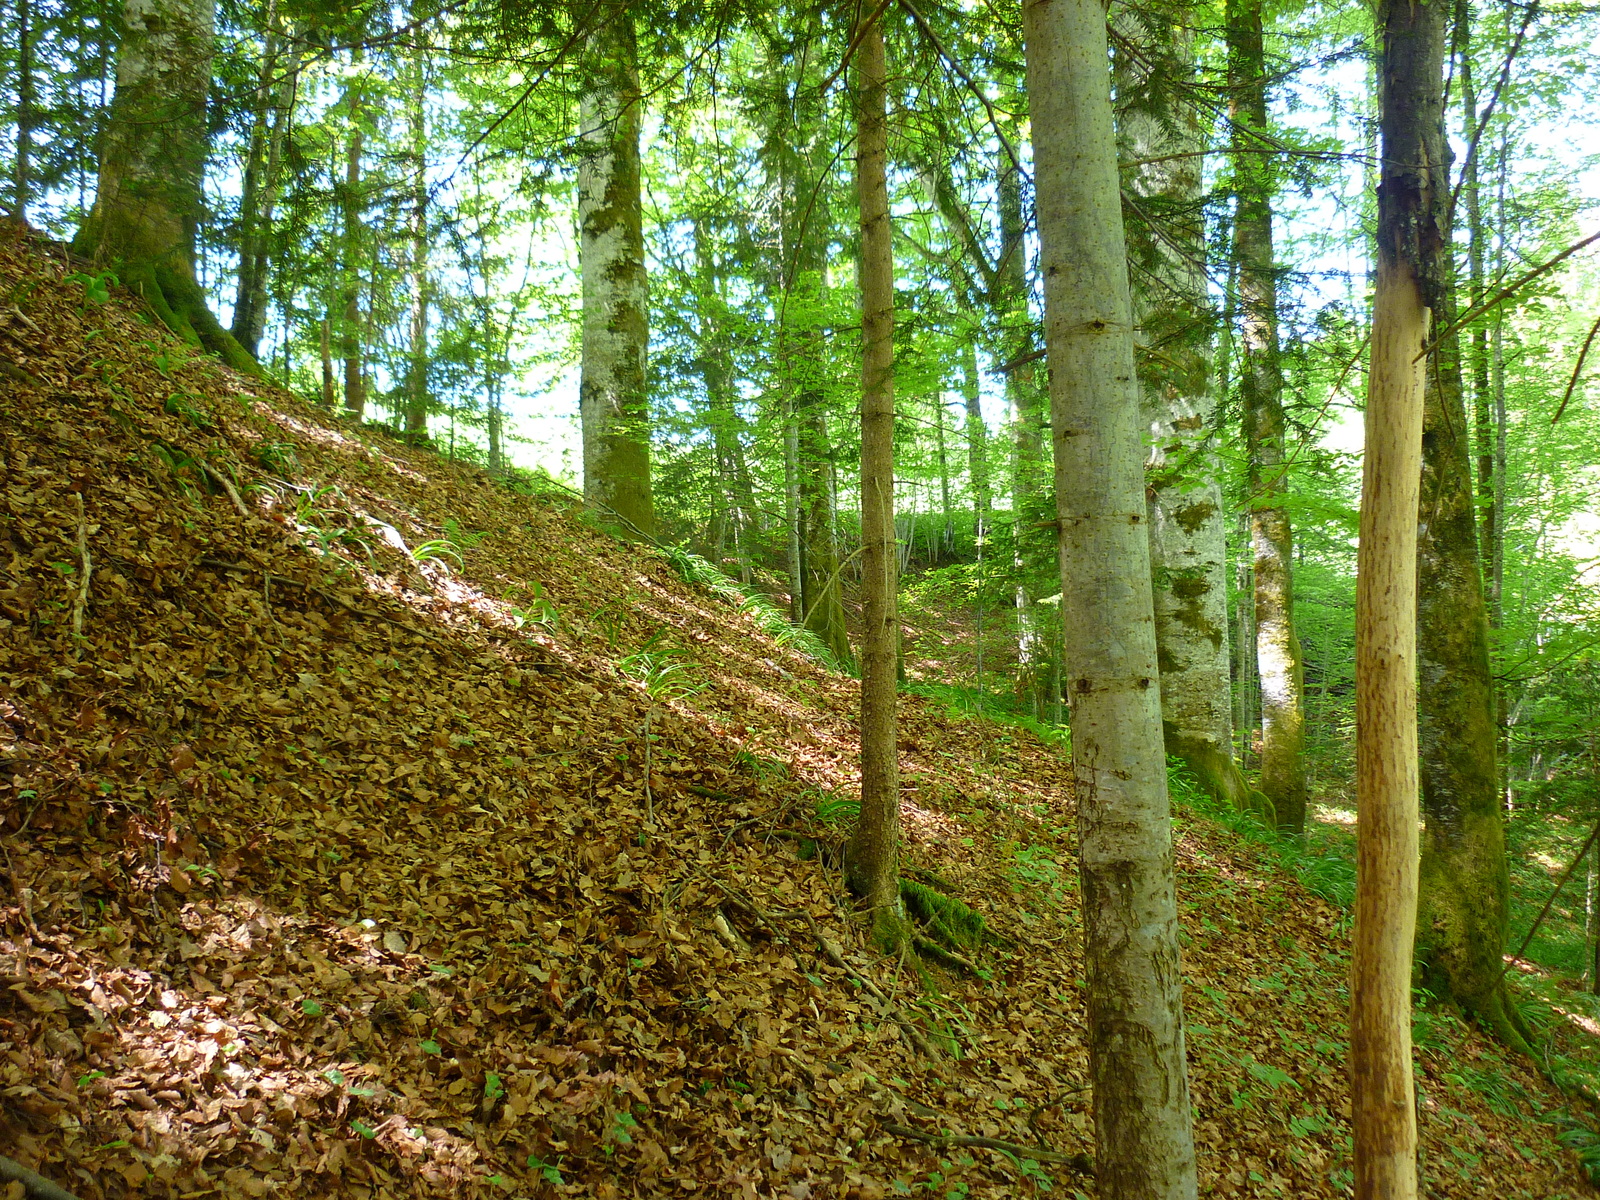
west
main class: Woodland
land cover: Broadleaved woodland
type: mountainous beech forest
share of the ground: > 75 %
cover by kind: broadleaved forest trees 85 %, coniferous forest trees 10 %, herbaceous plants 5 %
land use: Forestry
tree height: > 5 m
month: May
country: AT
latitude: 47.6692
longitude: 14.7810
